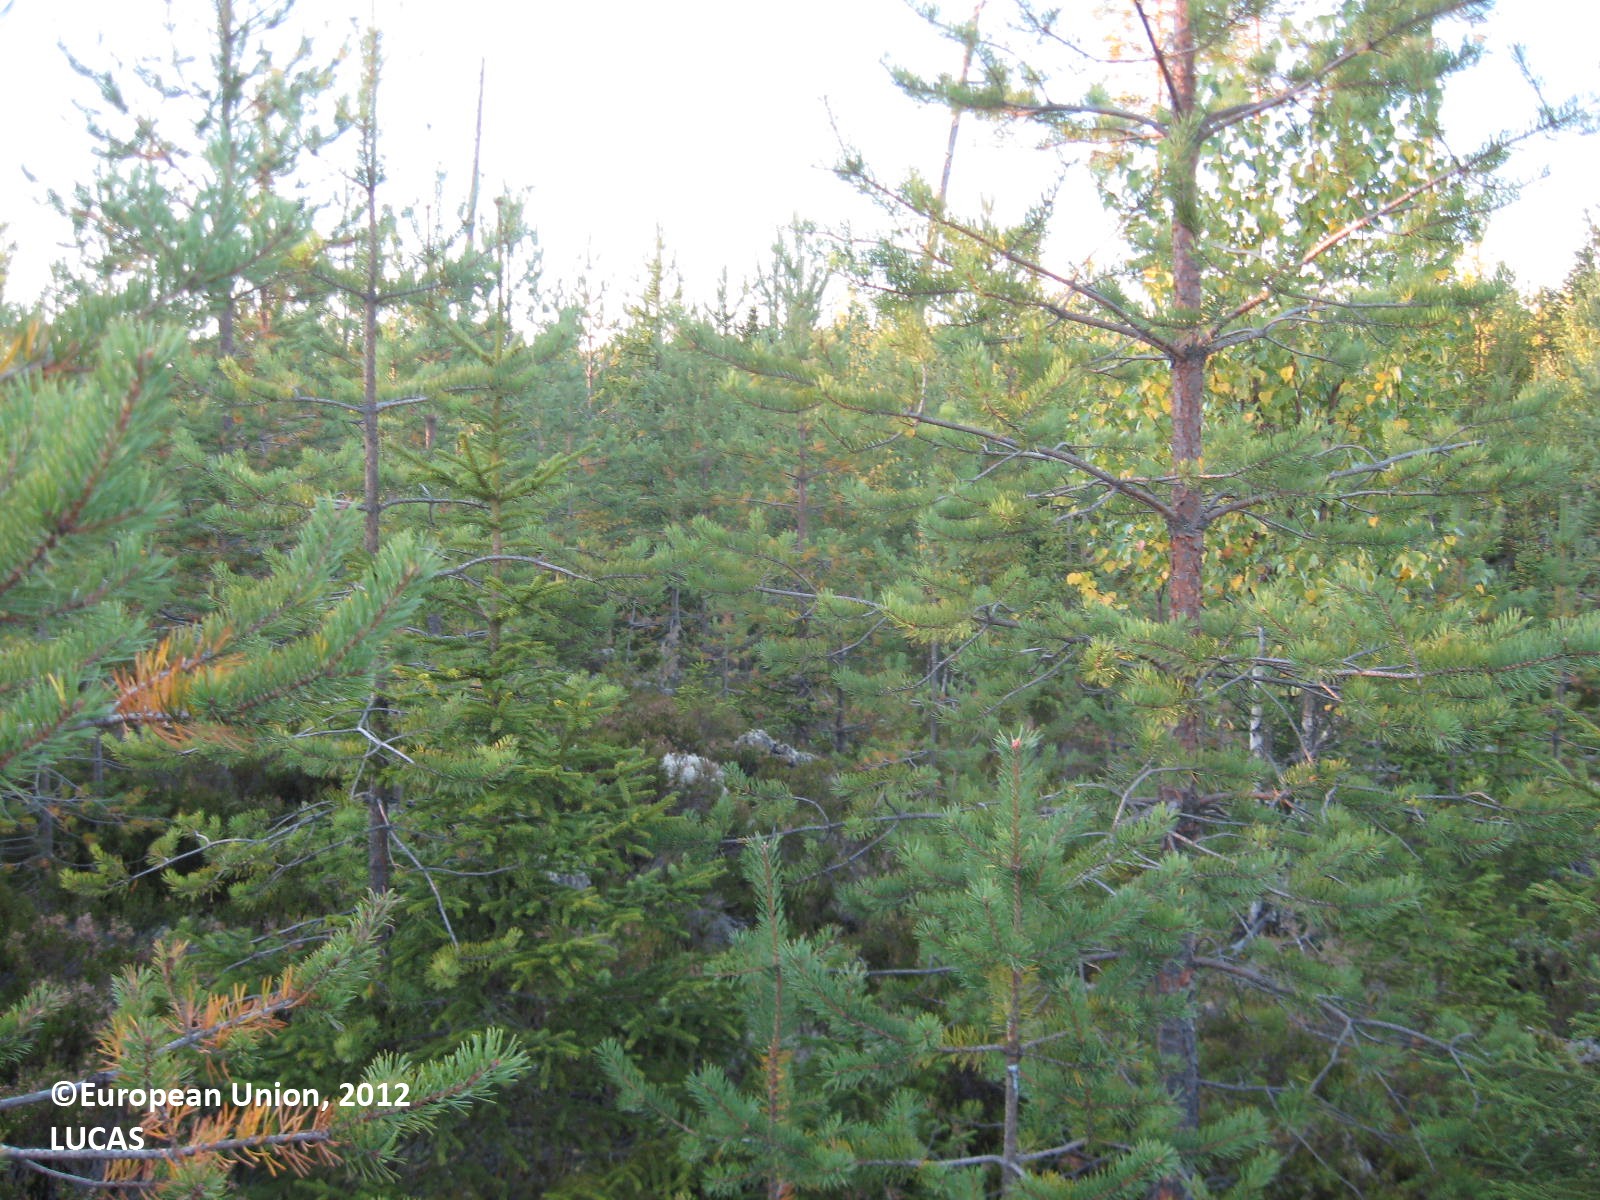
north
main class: Woodland
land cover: Pine dominated coniferous woodland
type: boreal forest
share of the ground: 50 - 75 %
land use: Forestry
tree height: < 5 m
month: August
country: FI
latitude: 63.8445
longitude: 29.7737
